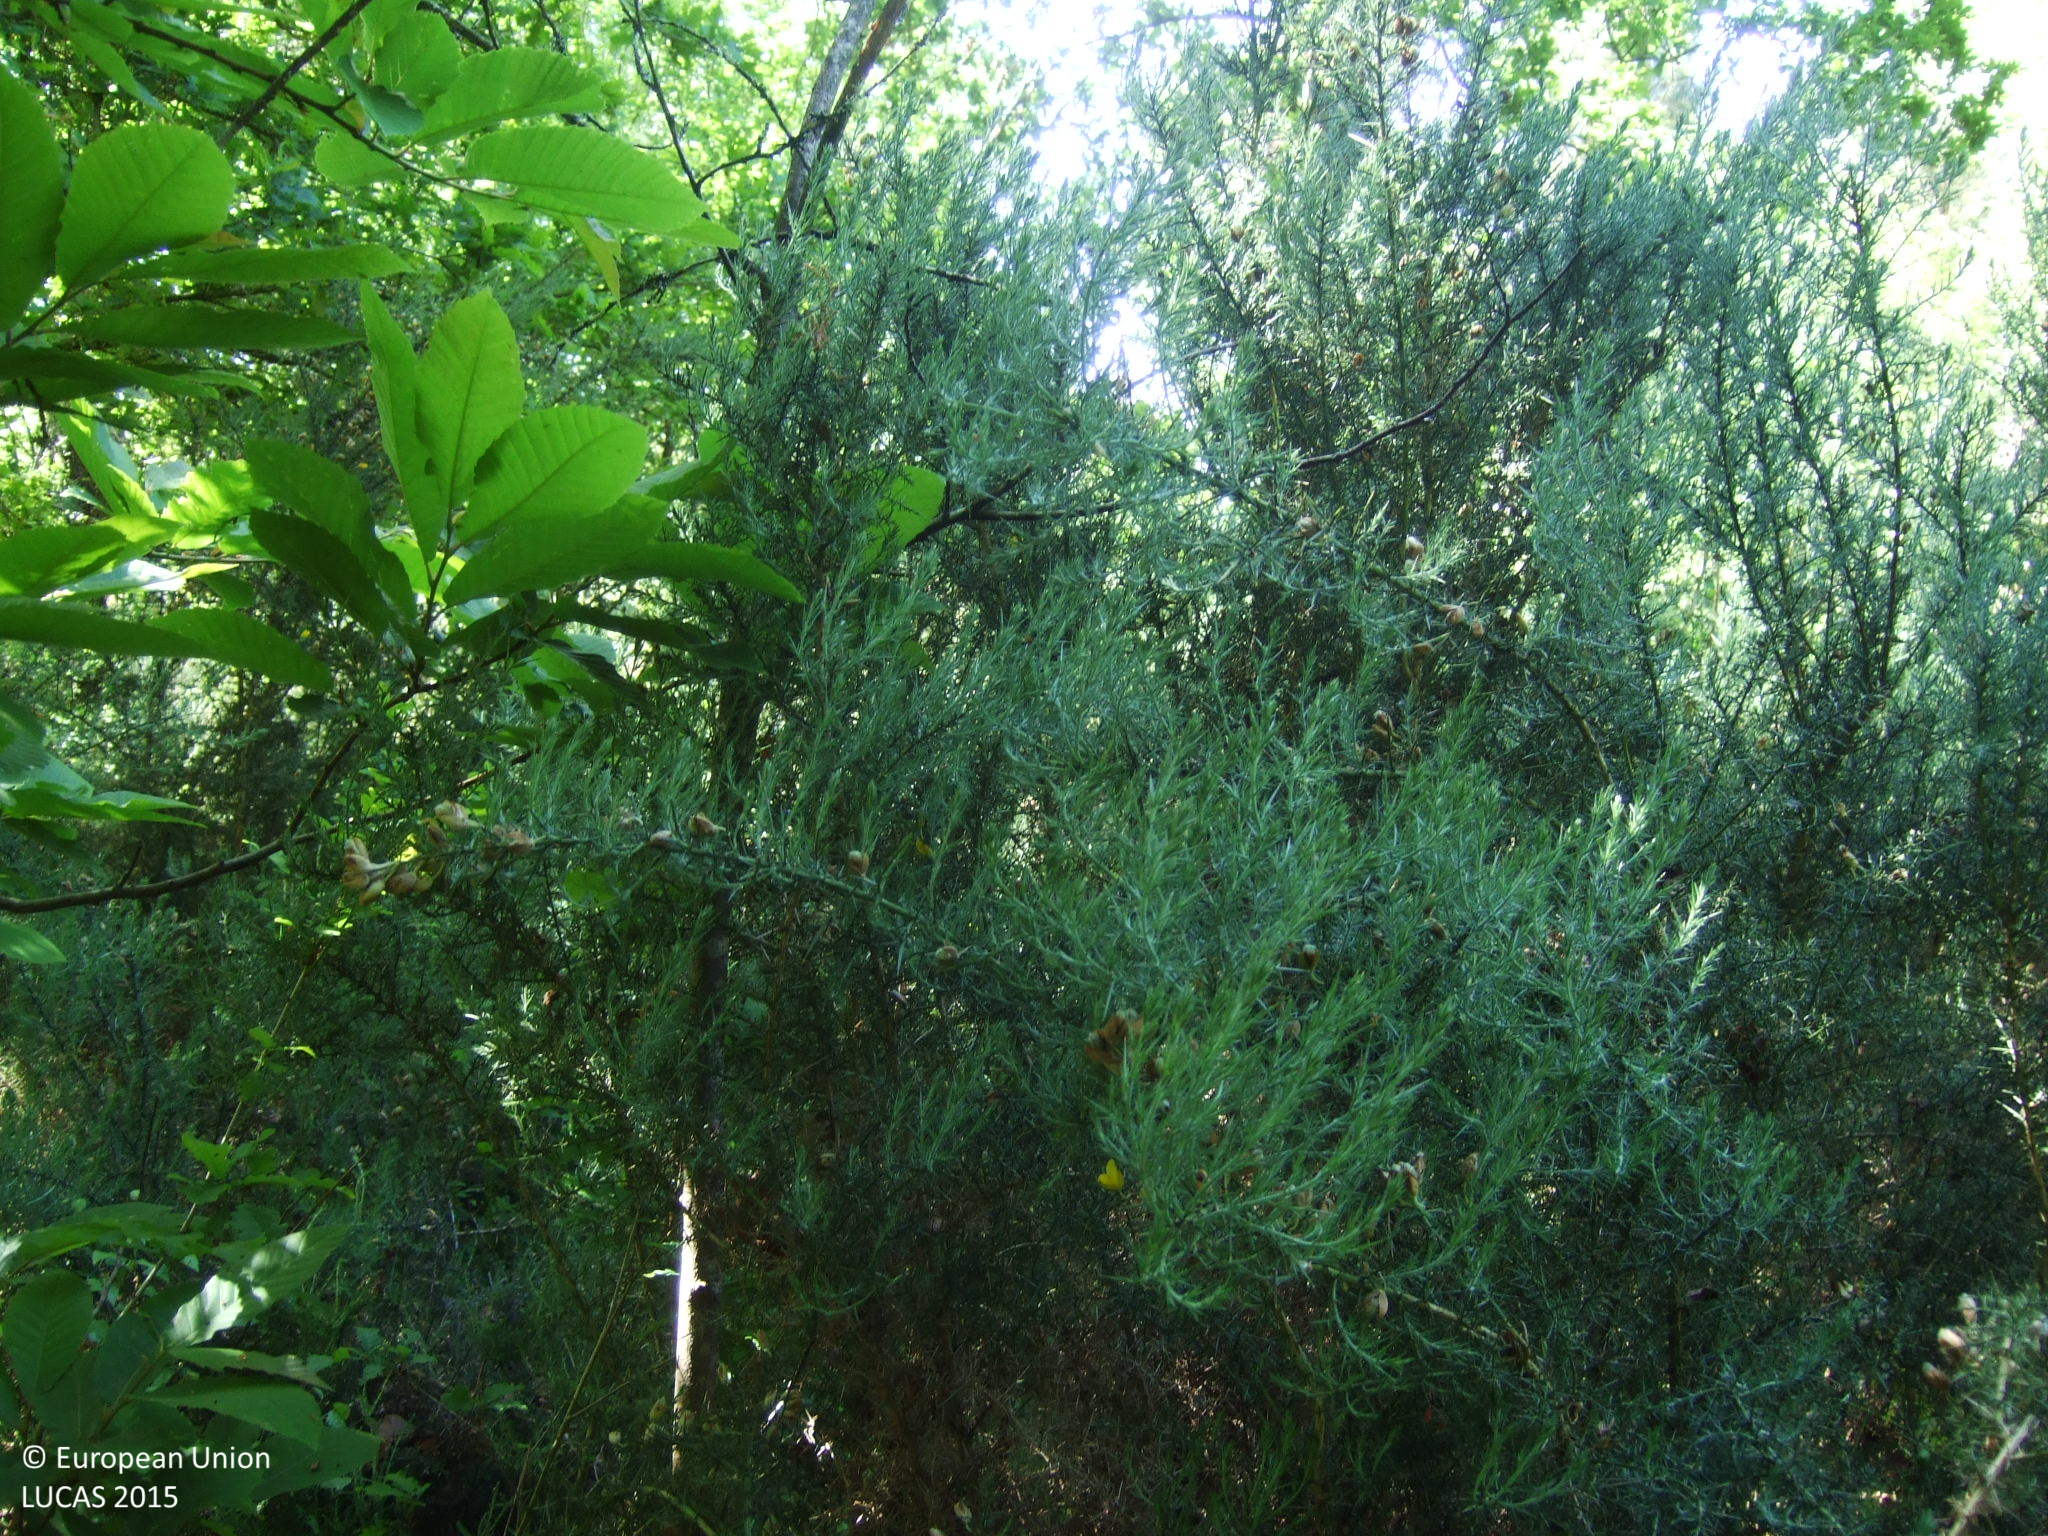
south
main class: Woodland
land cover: Broadleaved woodland
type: acidophilous oak and oak-birch forest
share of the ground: 50 - 75 %
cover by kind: broadleaved forest trees 60 %, shrubs 40 %
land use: Forestry
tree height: > 5 m
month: May
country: ES
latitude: 43.1363
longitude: -7.6494
